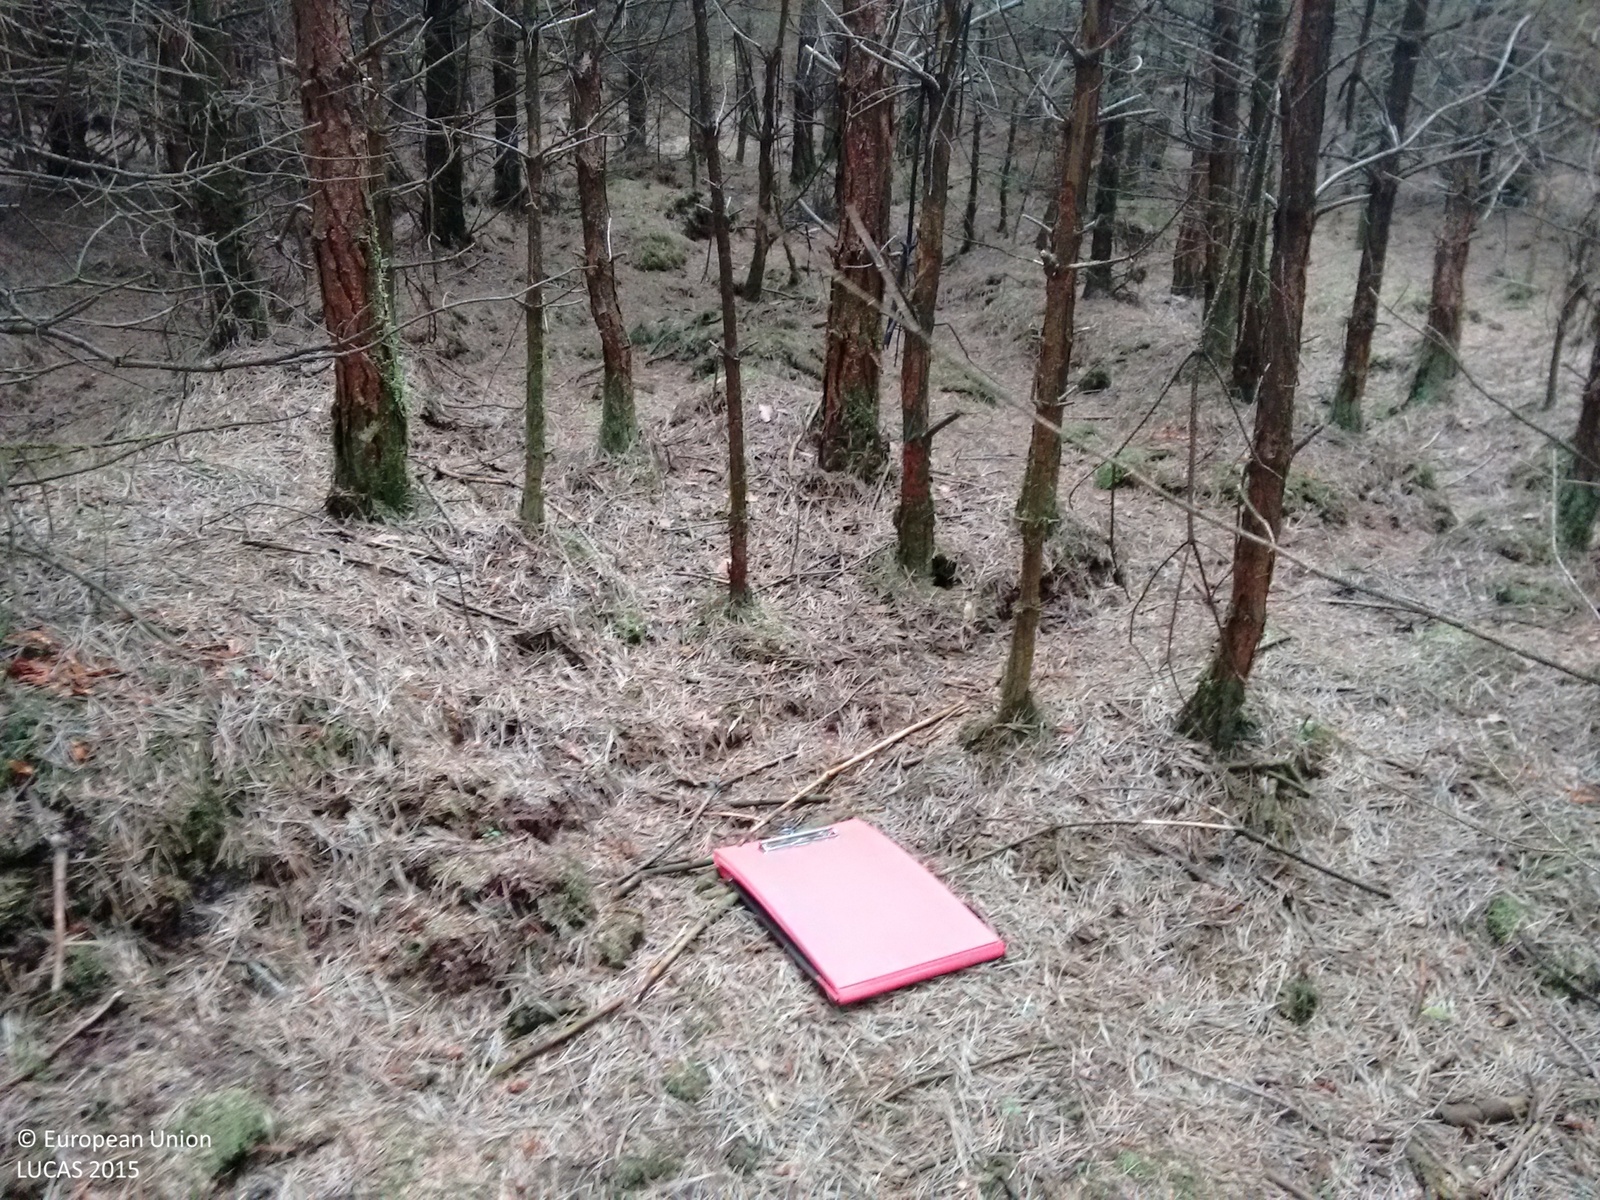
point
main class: Woodland
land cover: Pine dominated coniferous woodland
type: exotic forest
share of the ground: > 75 %
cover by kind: coniferous forest trees 80 %, broadleaved forest trees 20 %
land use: Forestry
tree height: > 5 m
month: June
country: GB
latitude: 54.3107
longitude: -0.8455
